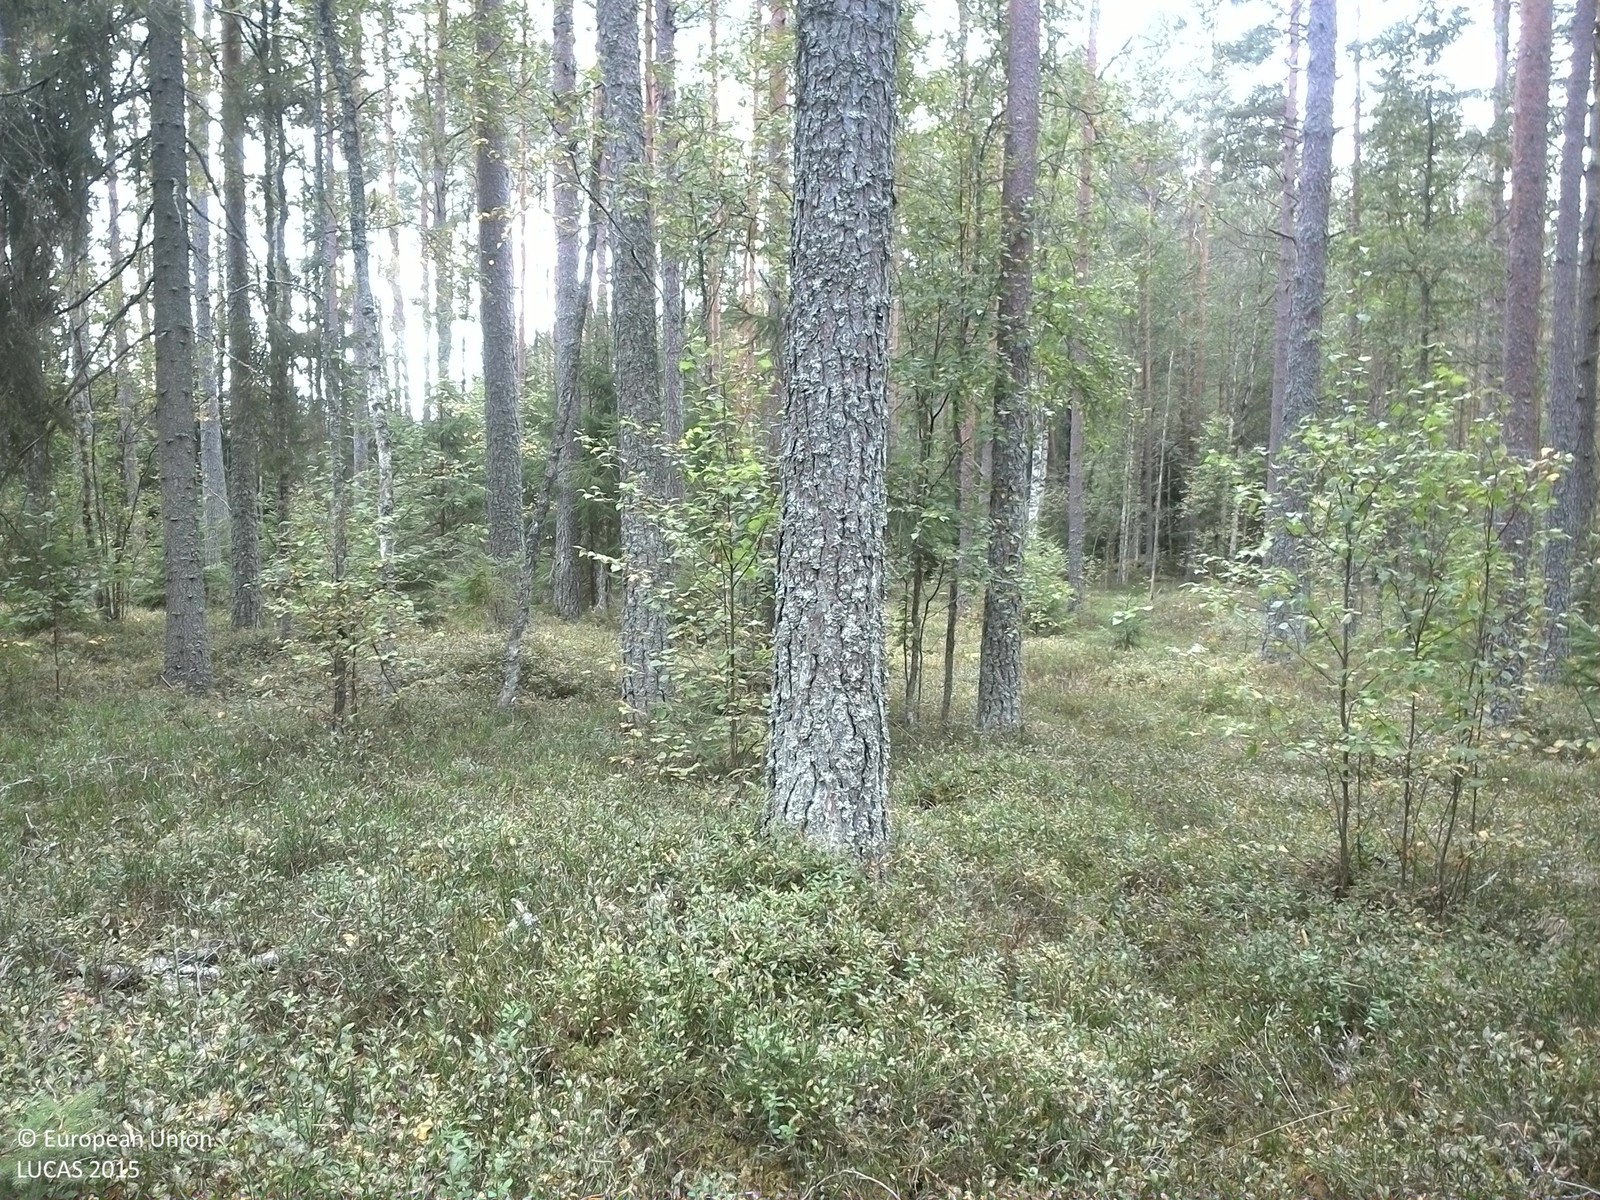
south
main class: Woodland
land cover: Pine dominated coniferous woodland
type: boreal forest
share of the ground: 50 - 75 %
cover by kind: coniferous forest trees 70 %, shrubs 20 %, broadleaved forest trees 5 %, lichens and mosses 5 %
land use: Forestry
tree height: > 5 m
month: September
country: SE
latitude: 59.7418
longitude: 13.4608
